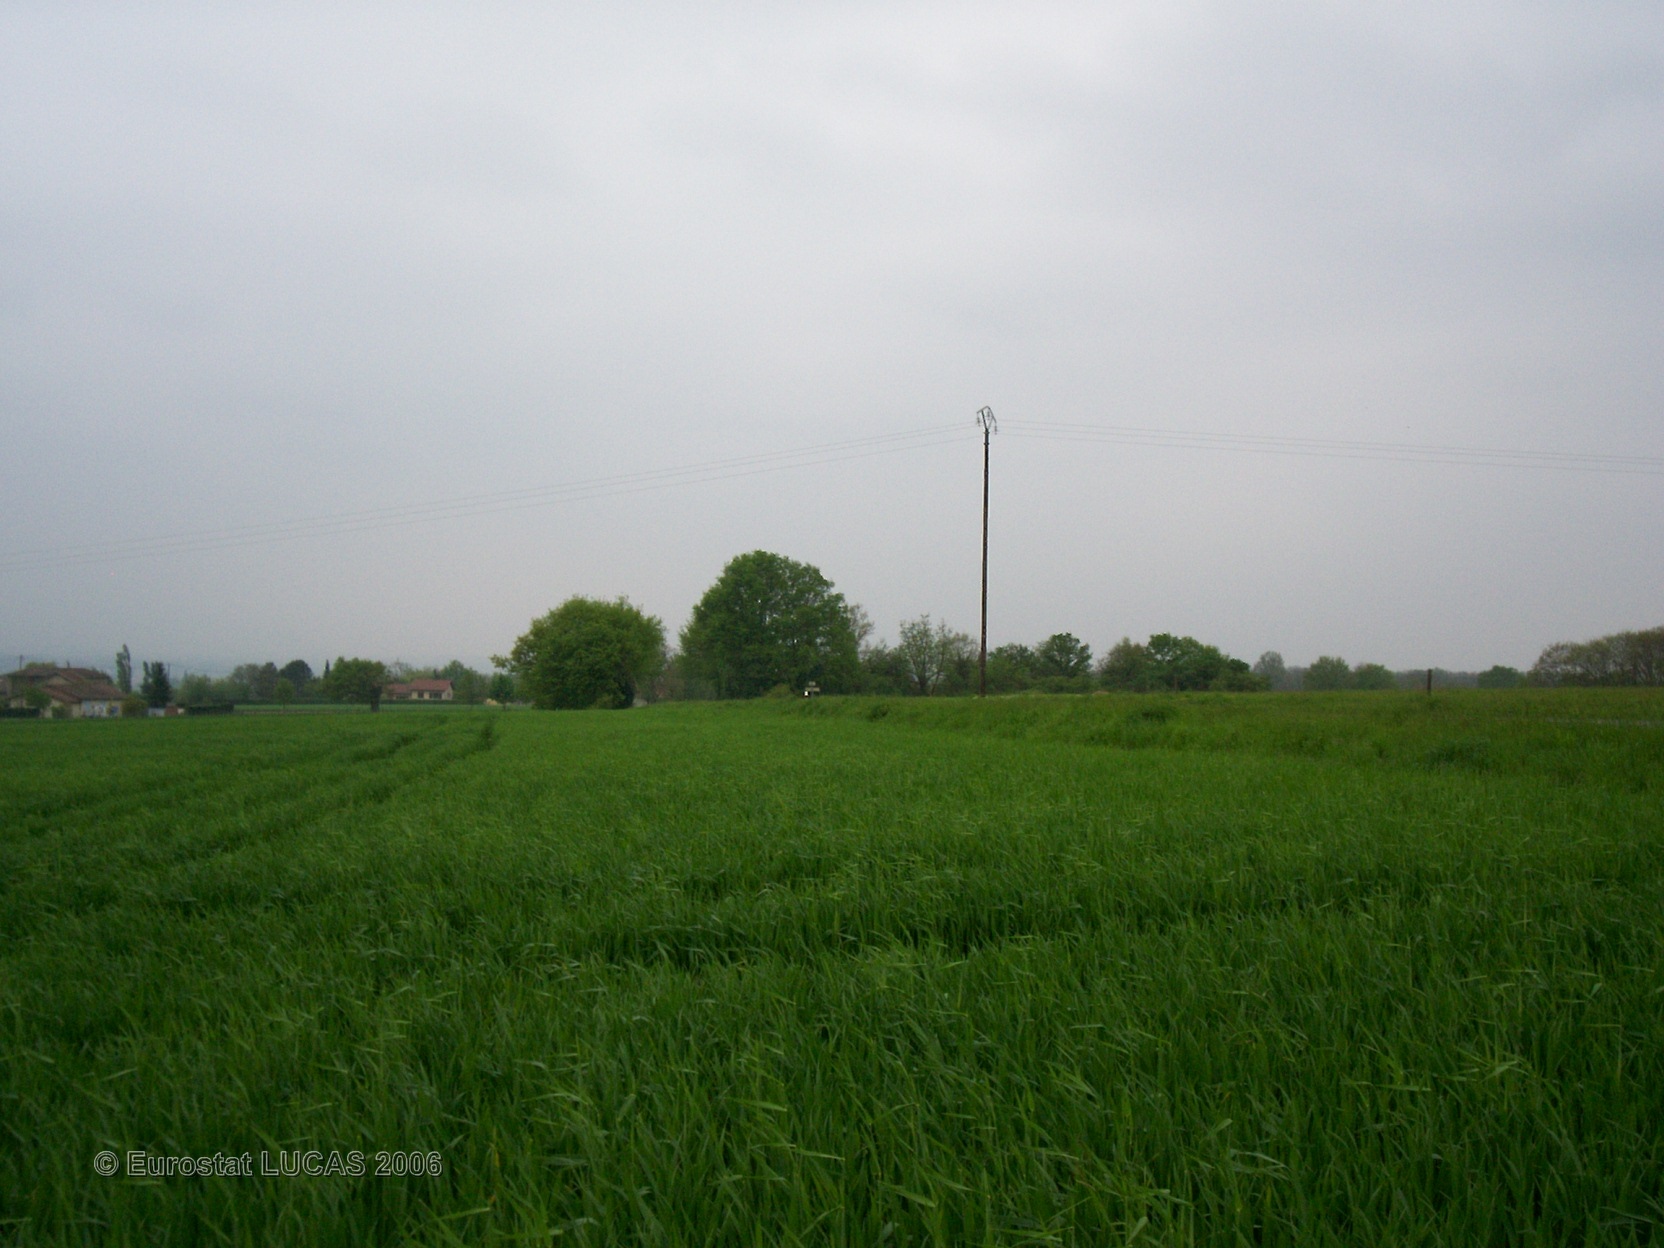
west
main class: Cropland
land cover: Common wheat
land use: Agriculture (excluding fallow land and kitchen gardens)
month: April
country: FR
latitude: 46.0799
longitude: 4.7915
